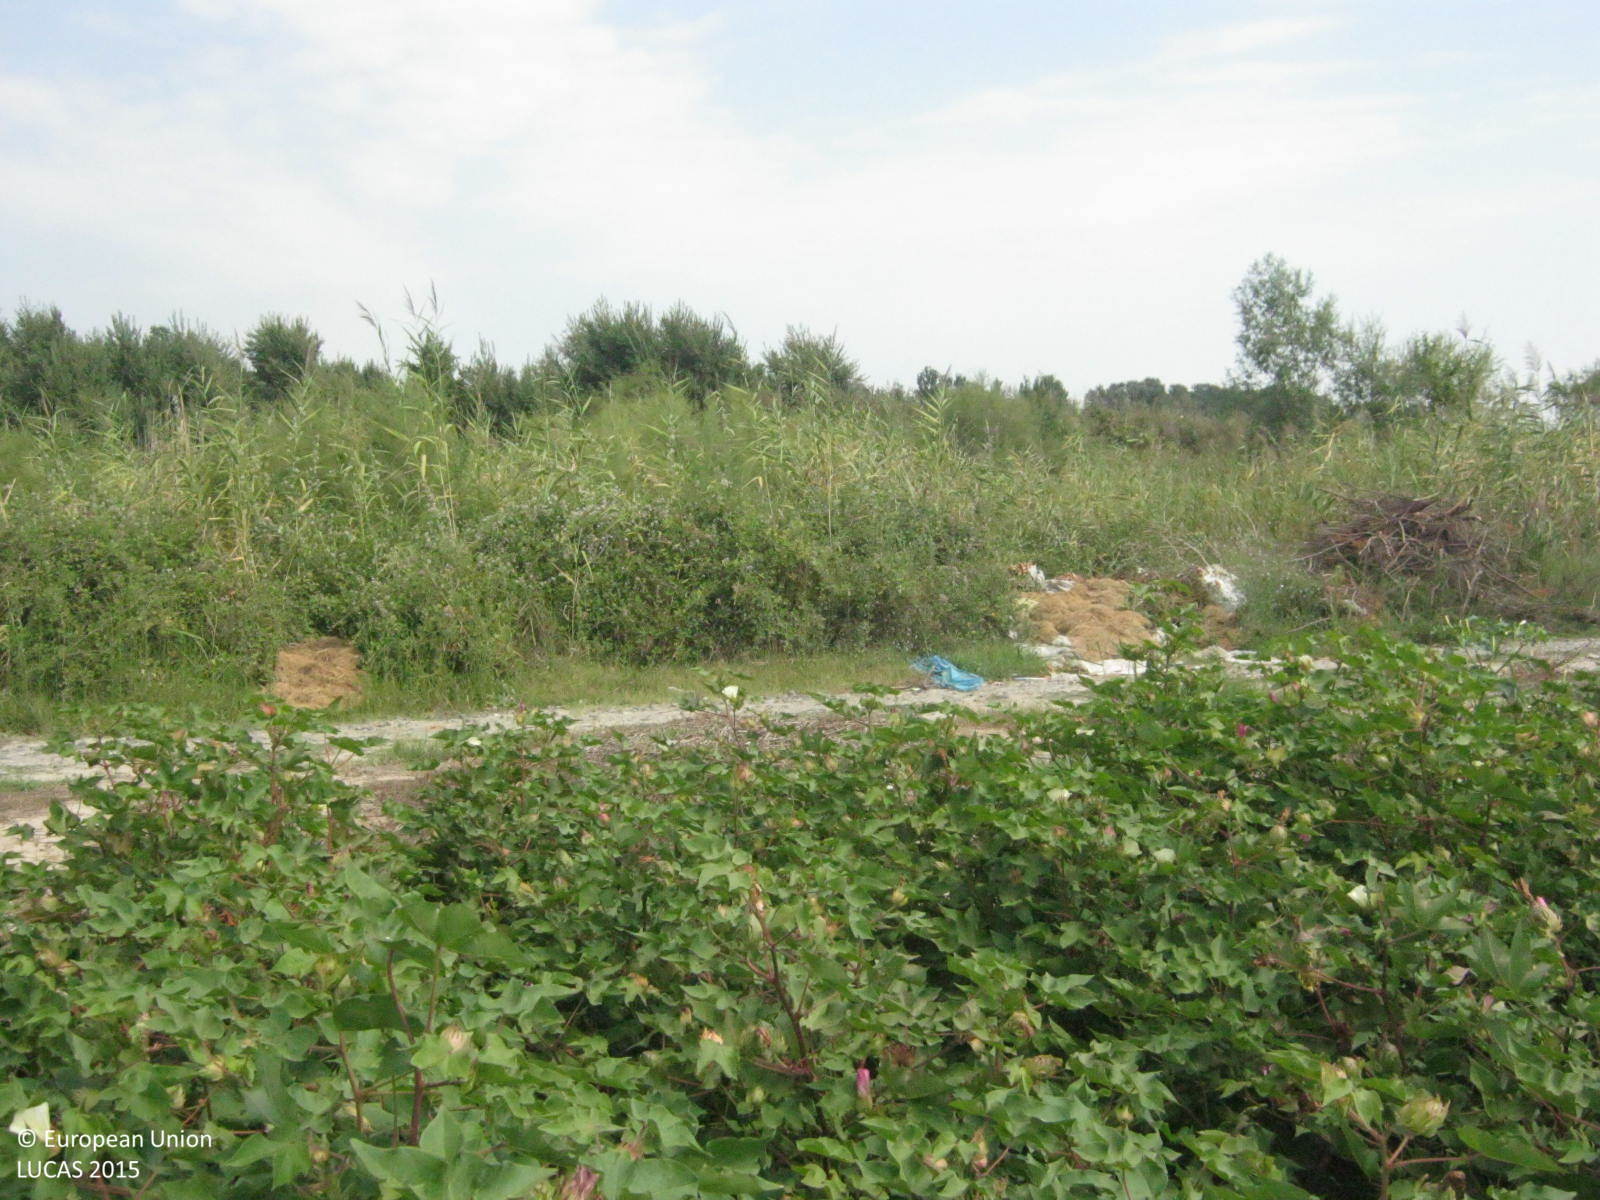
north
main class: Cropland
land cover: Cotton
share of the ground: > 75 %
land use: Agriculture (excluding fallow land and kitchen gardens)
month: August
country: GR
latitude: 40.5543
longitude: 22.5552
